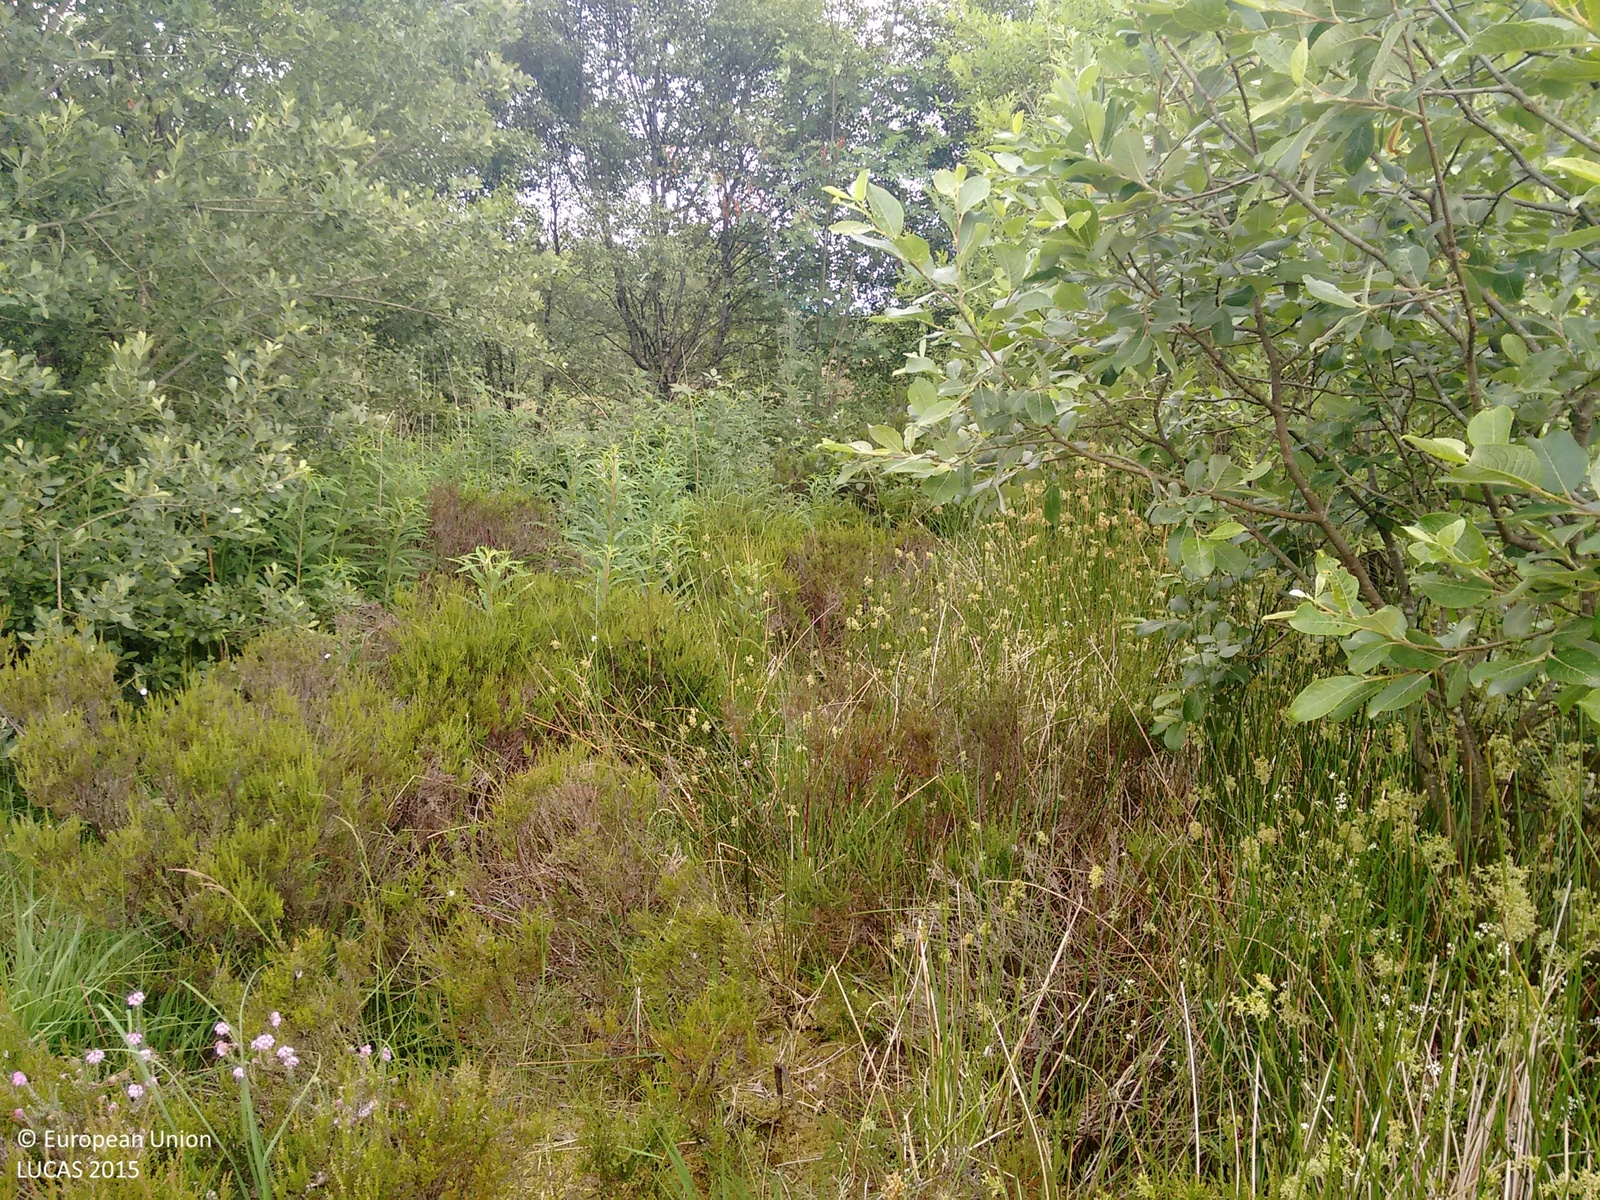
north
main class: Shrubland
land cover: Shrubland with sparse tree cover
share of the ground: > 75 %
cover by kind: shrubs 95 %, broadleaved forest trees 5 %
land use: Semi-natural and natural areas not in use
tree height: > 5 m
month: July
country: GB
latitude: 53.1970
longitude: -1.5016
